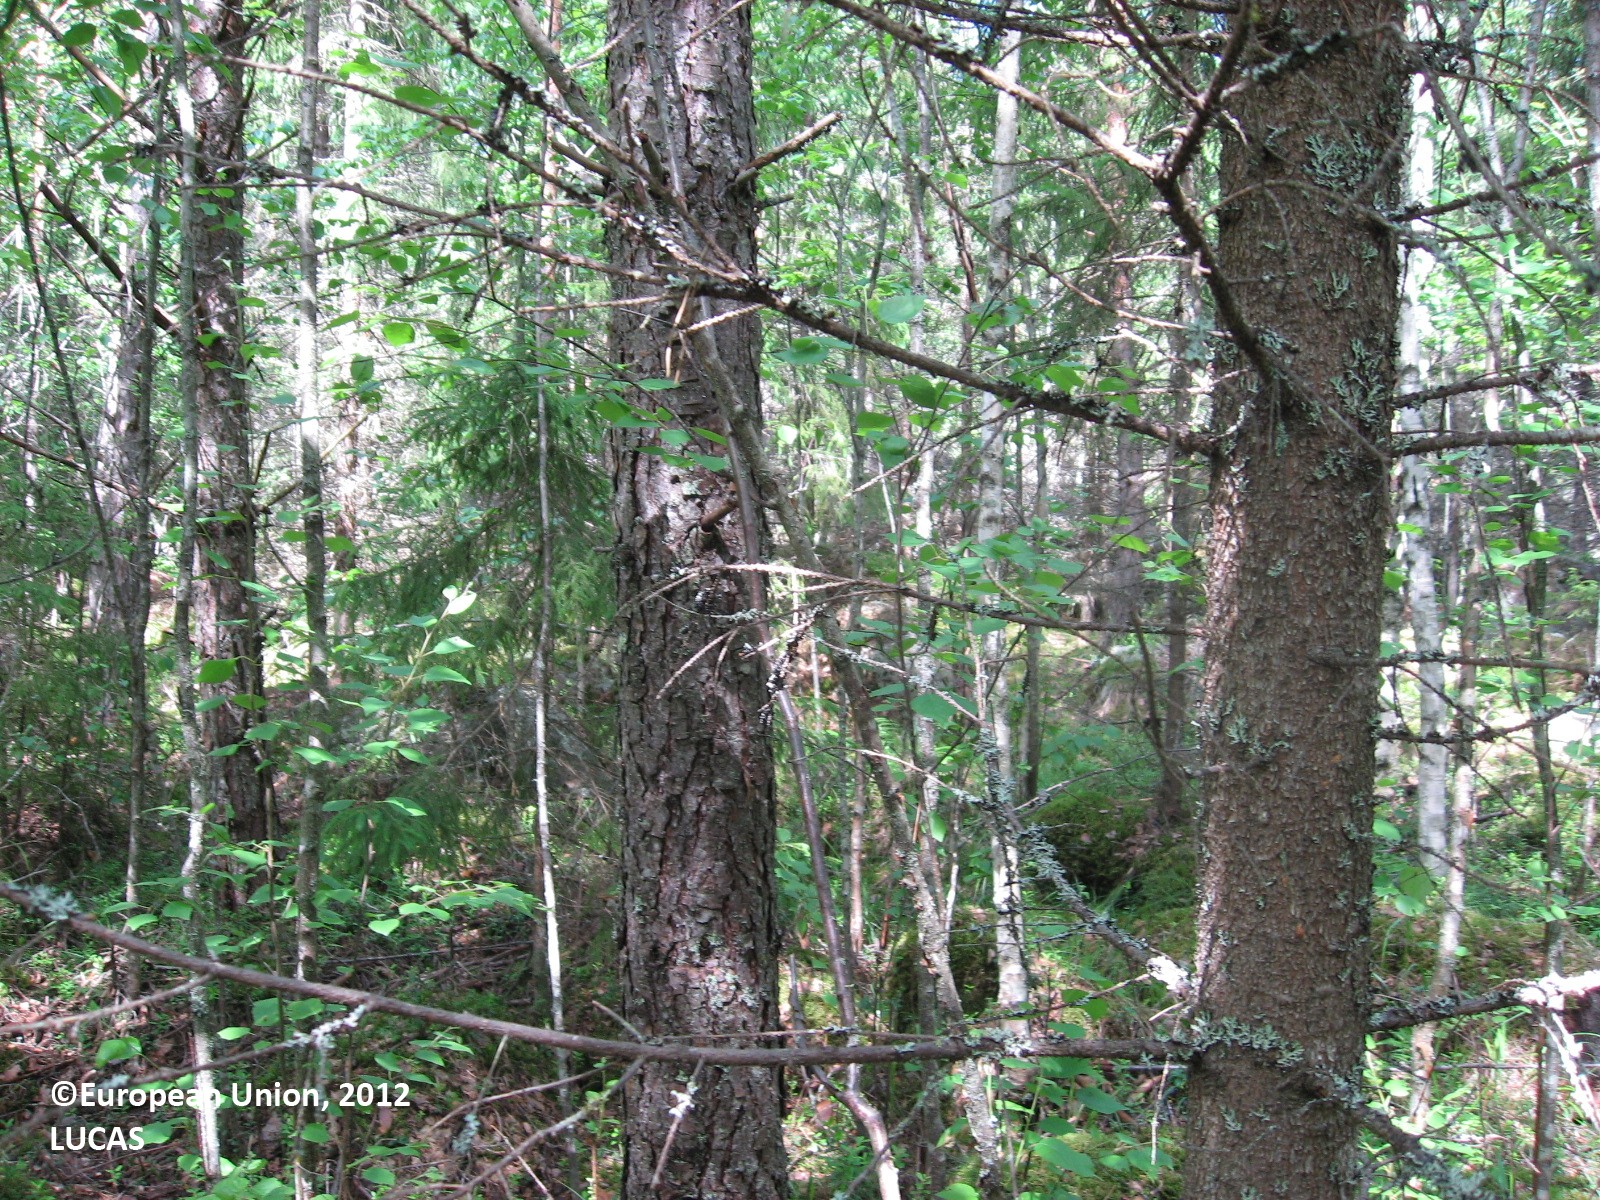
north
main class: Woodland
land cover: Spruce dominated mixed woodland
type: boreal forest
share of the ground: > 75 %
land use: Forestry
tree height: > 5 m
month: June
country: FI
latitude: 60.5522
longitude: 26.2875
